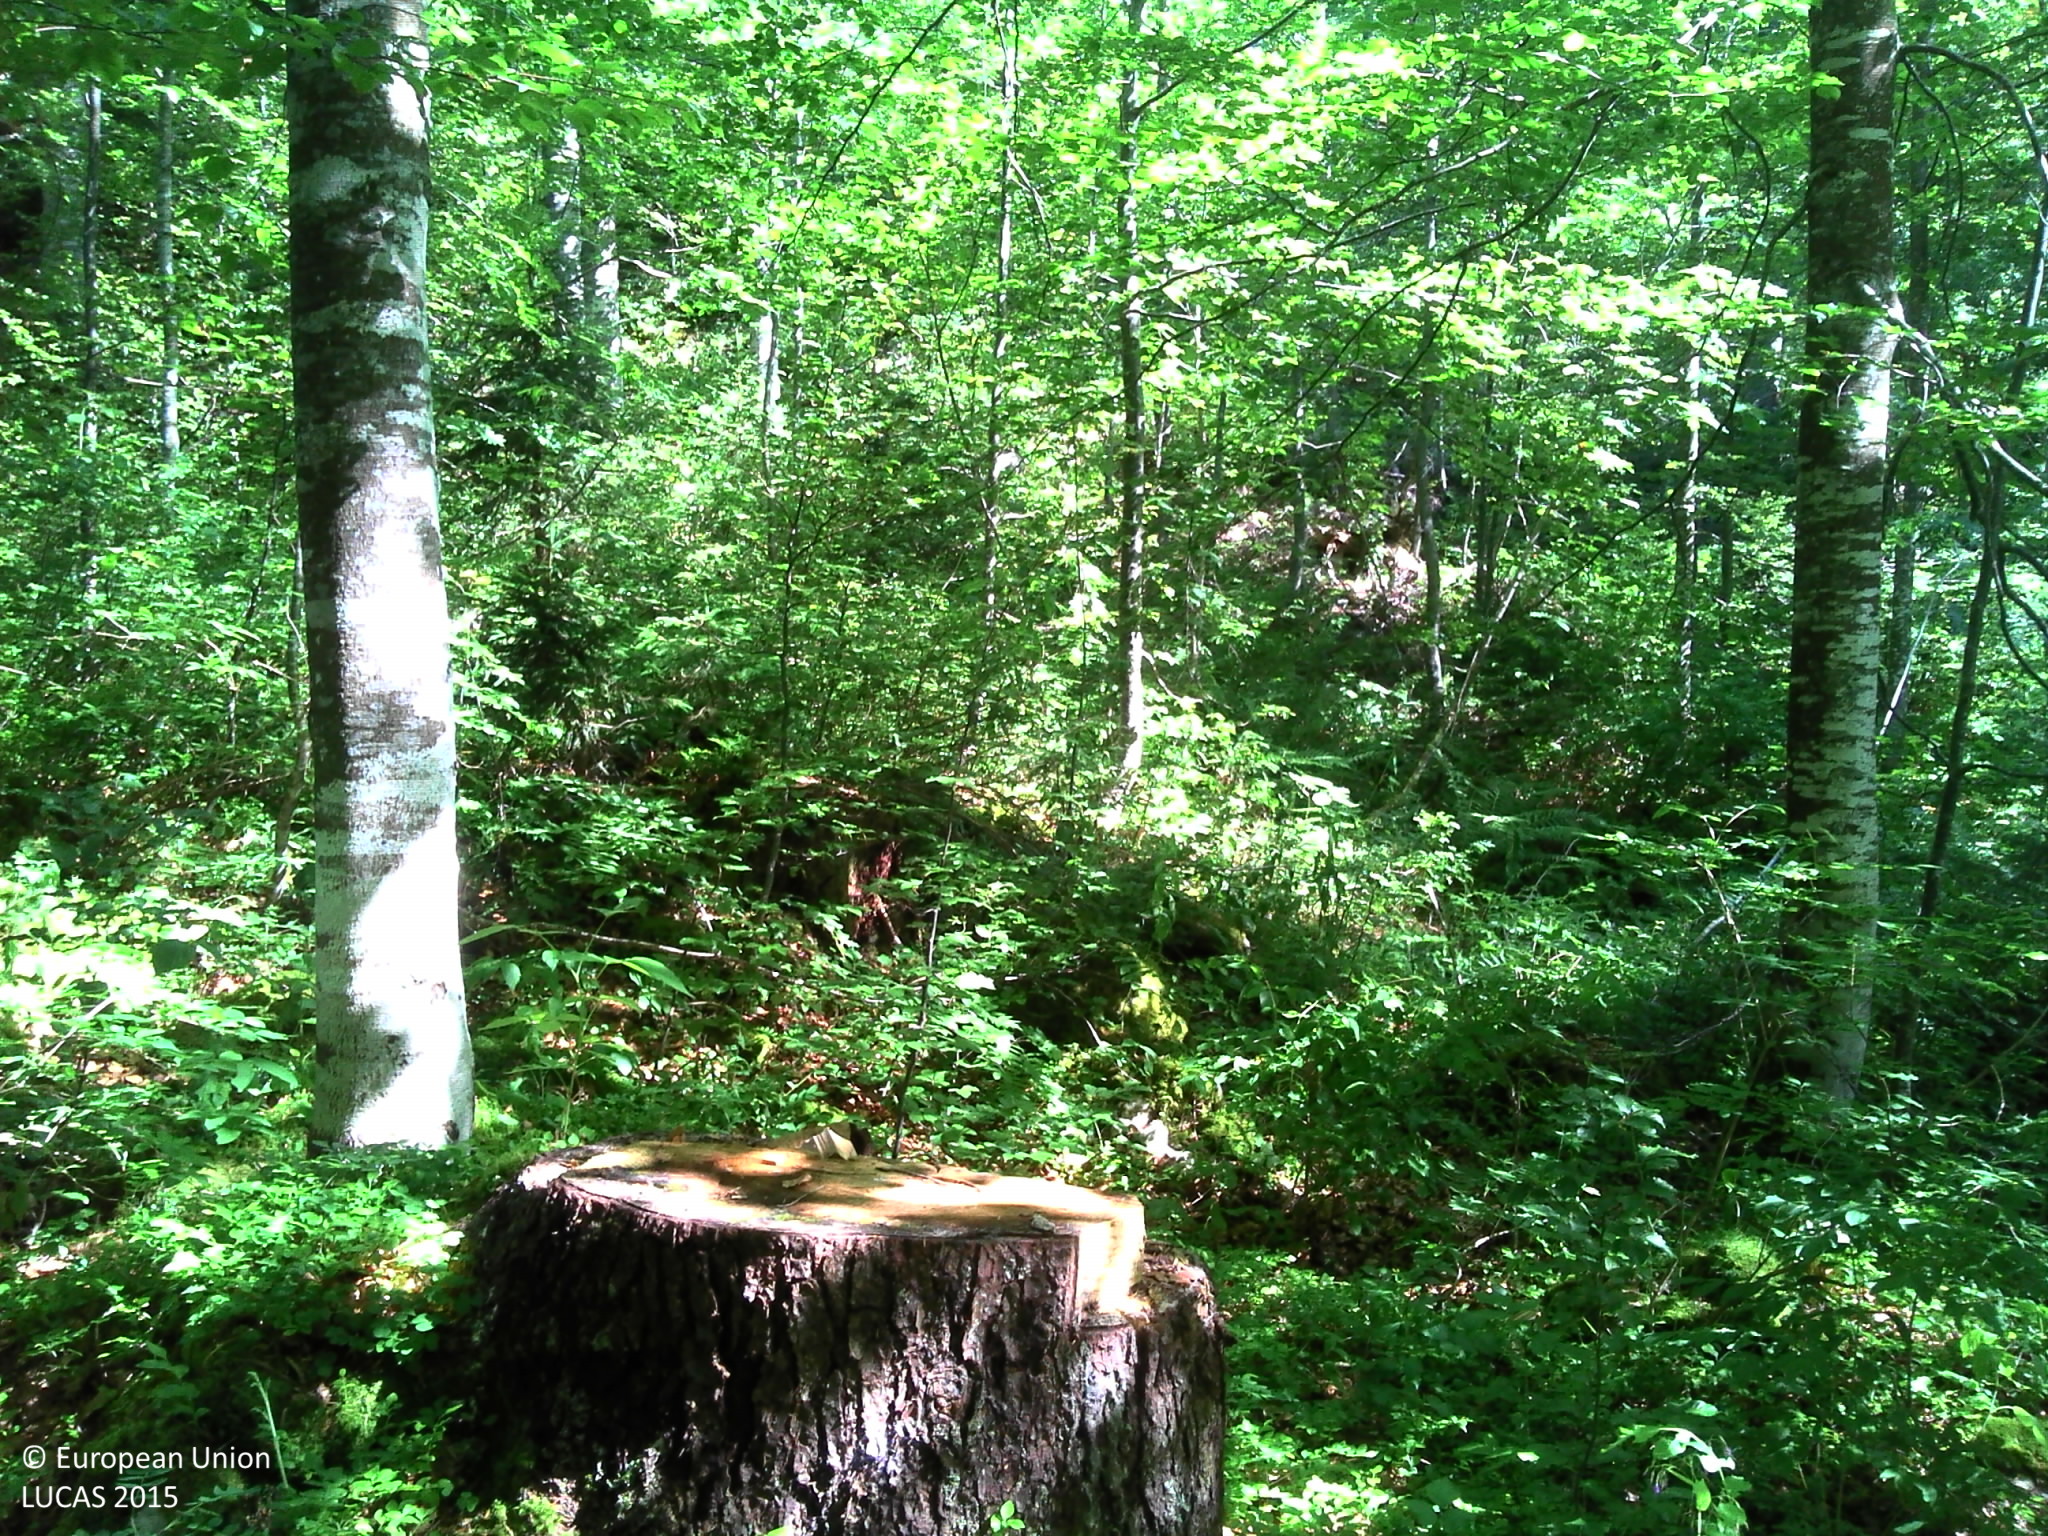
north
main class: Woodland
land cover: Spruce dominated mixed woodland
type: mountainous beech forest
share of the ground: > 75 %
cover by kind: broadleaved forest trees 35 %, coniferous forest trees 30 %, consolidated bare surface 20 %, lichens and mosses 10 %, herbaceous plants 5 %
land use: Forestry
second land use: Sport
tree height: > 5 m
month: July
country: FR
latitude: 46.5687
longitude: 6.1019
